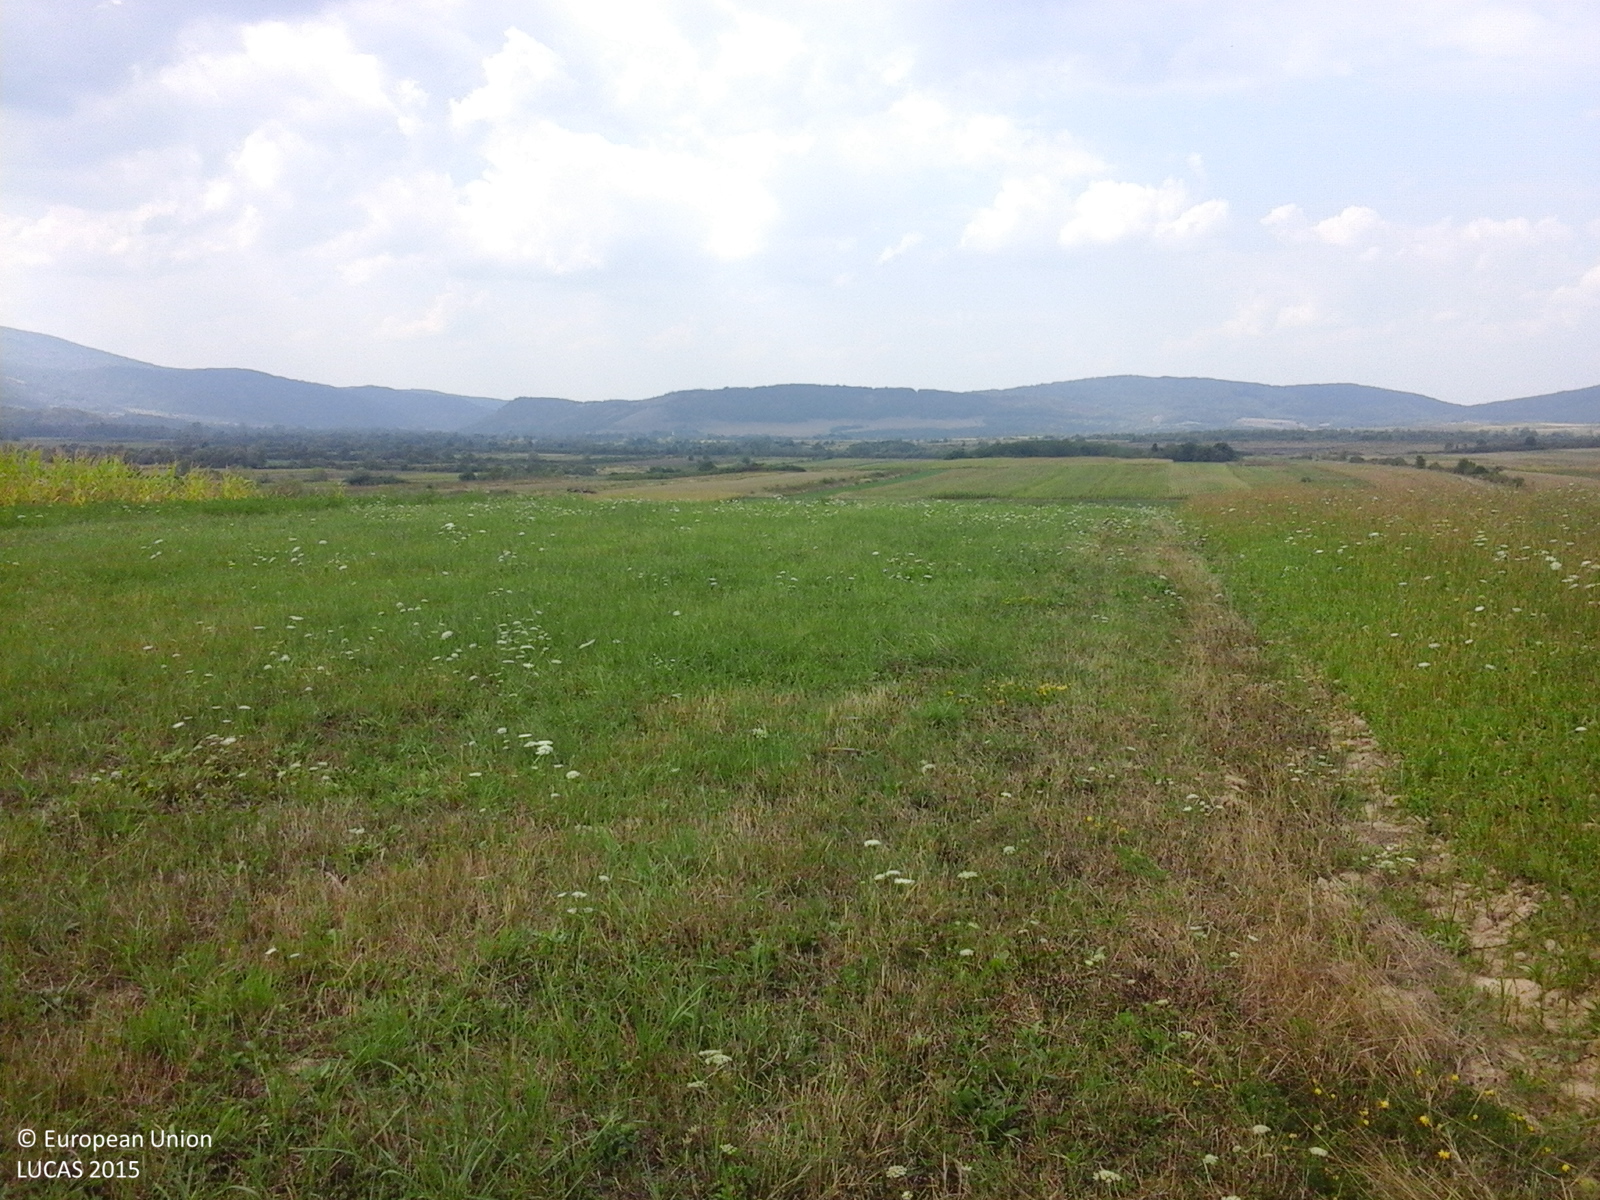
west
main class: Grassland
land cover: Grassland without tree/shrub cover
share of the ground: > 75 %
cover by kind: herbaceous plants 100 %
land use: Agriculture (excluding fallow land and kitchen gardens)
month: August
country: RO
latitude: 46.3188
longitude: 22.2416
